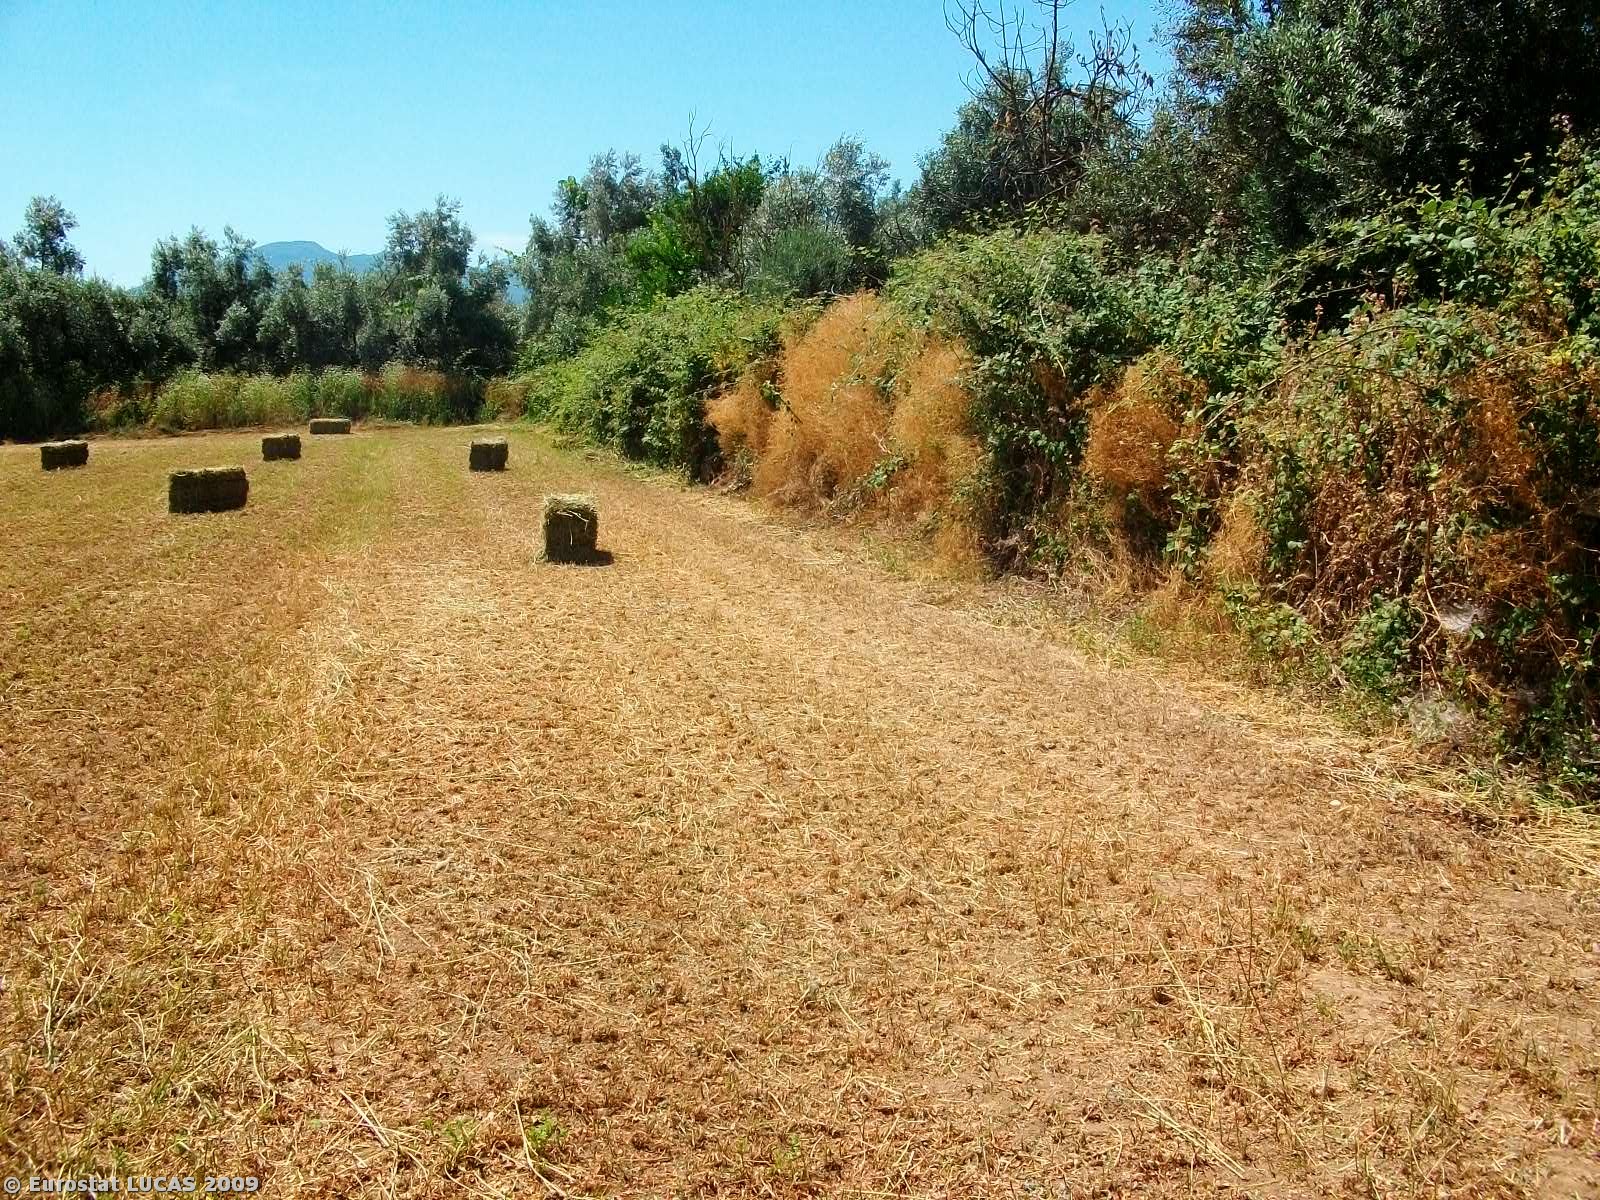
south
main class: Cropland
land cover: Lucerne
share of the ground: > 75 %
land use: Agriculture (excluding fallow land and kitchen gardens)
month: June
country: GR
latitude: 38.5733
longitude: 21.4361
